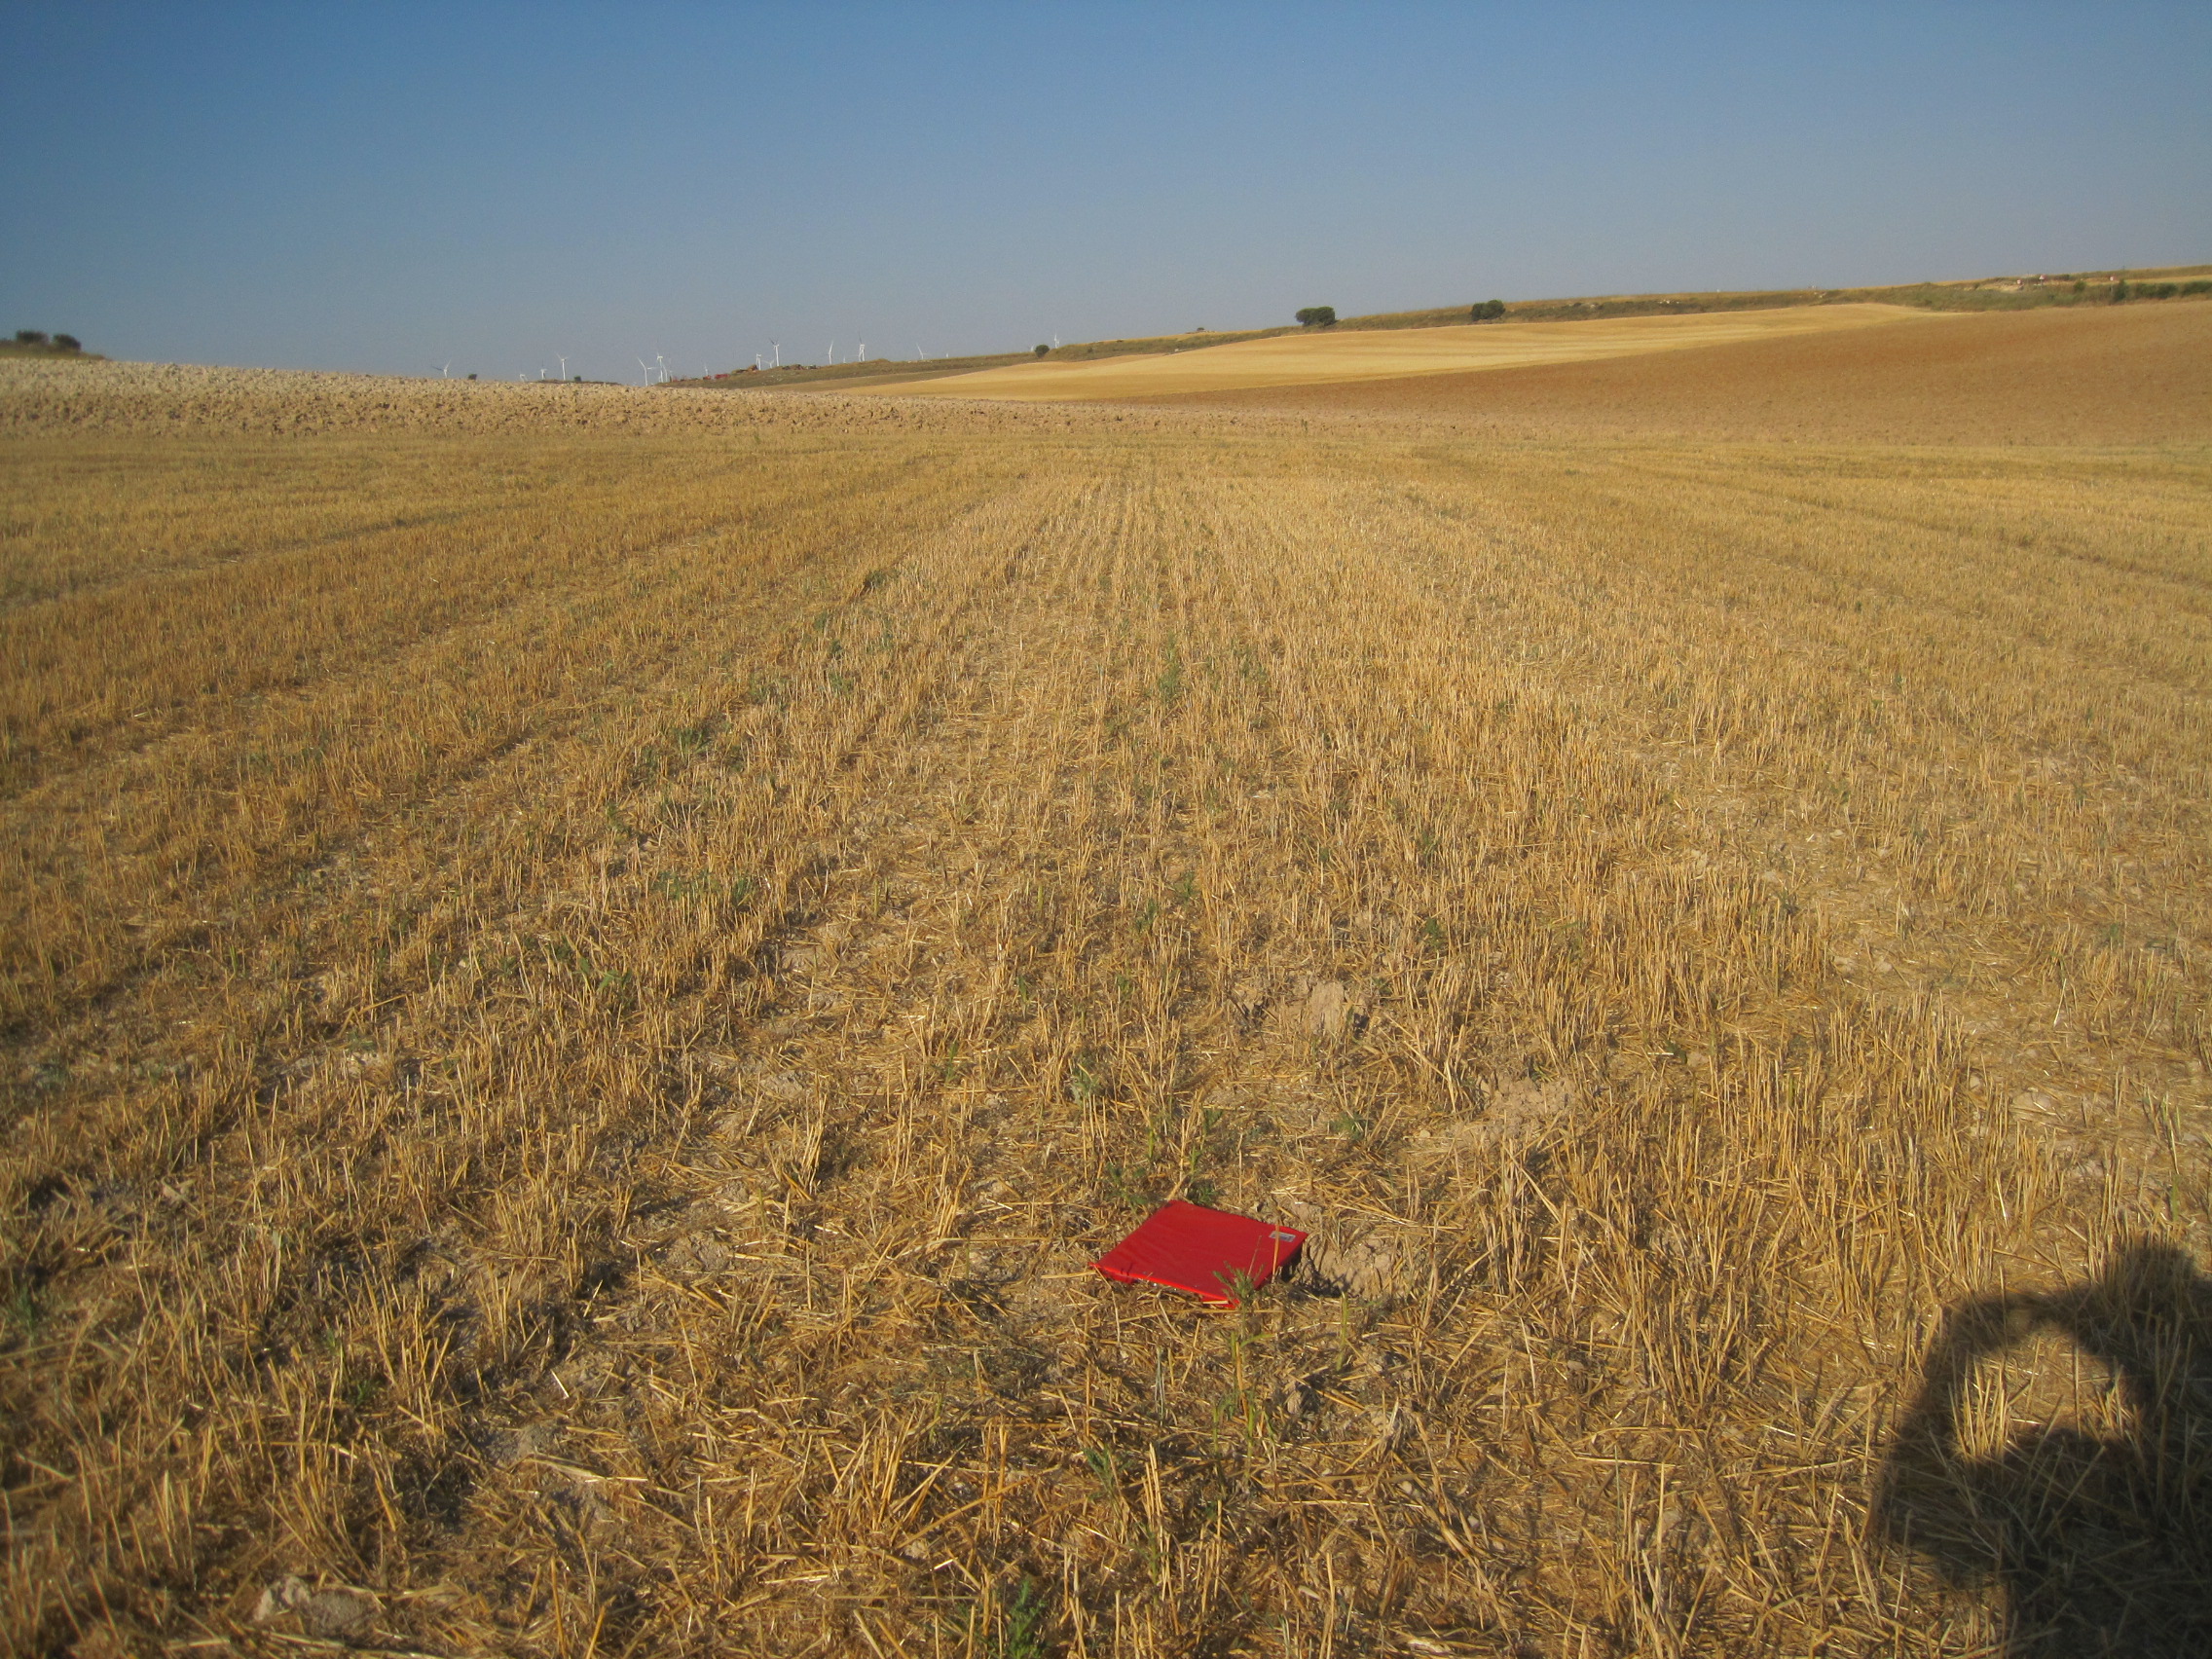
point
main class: Cropland
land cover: Barley
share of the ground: < 10 %
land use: Agriculture (excluding fallow land and kitchen gardens)
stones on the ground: 10 - 25 %
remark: Harvested field
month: July
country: ES
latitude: 41.6753
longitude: -5.1276
